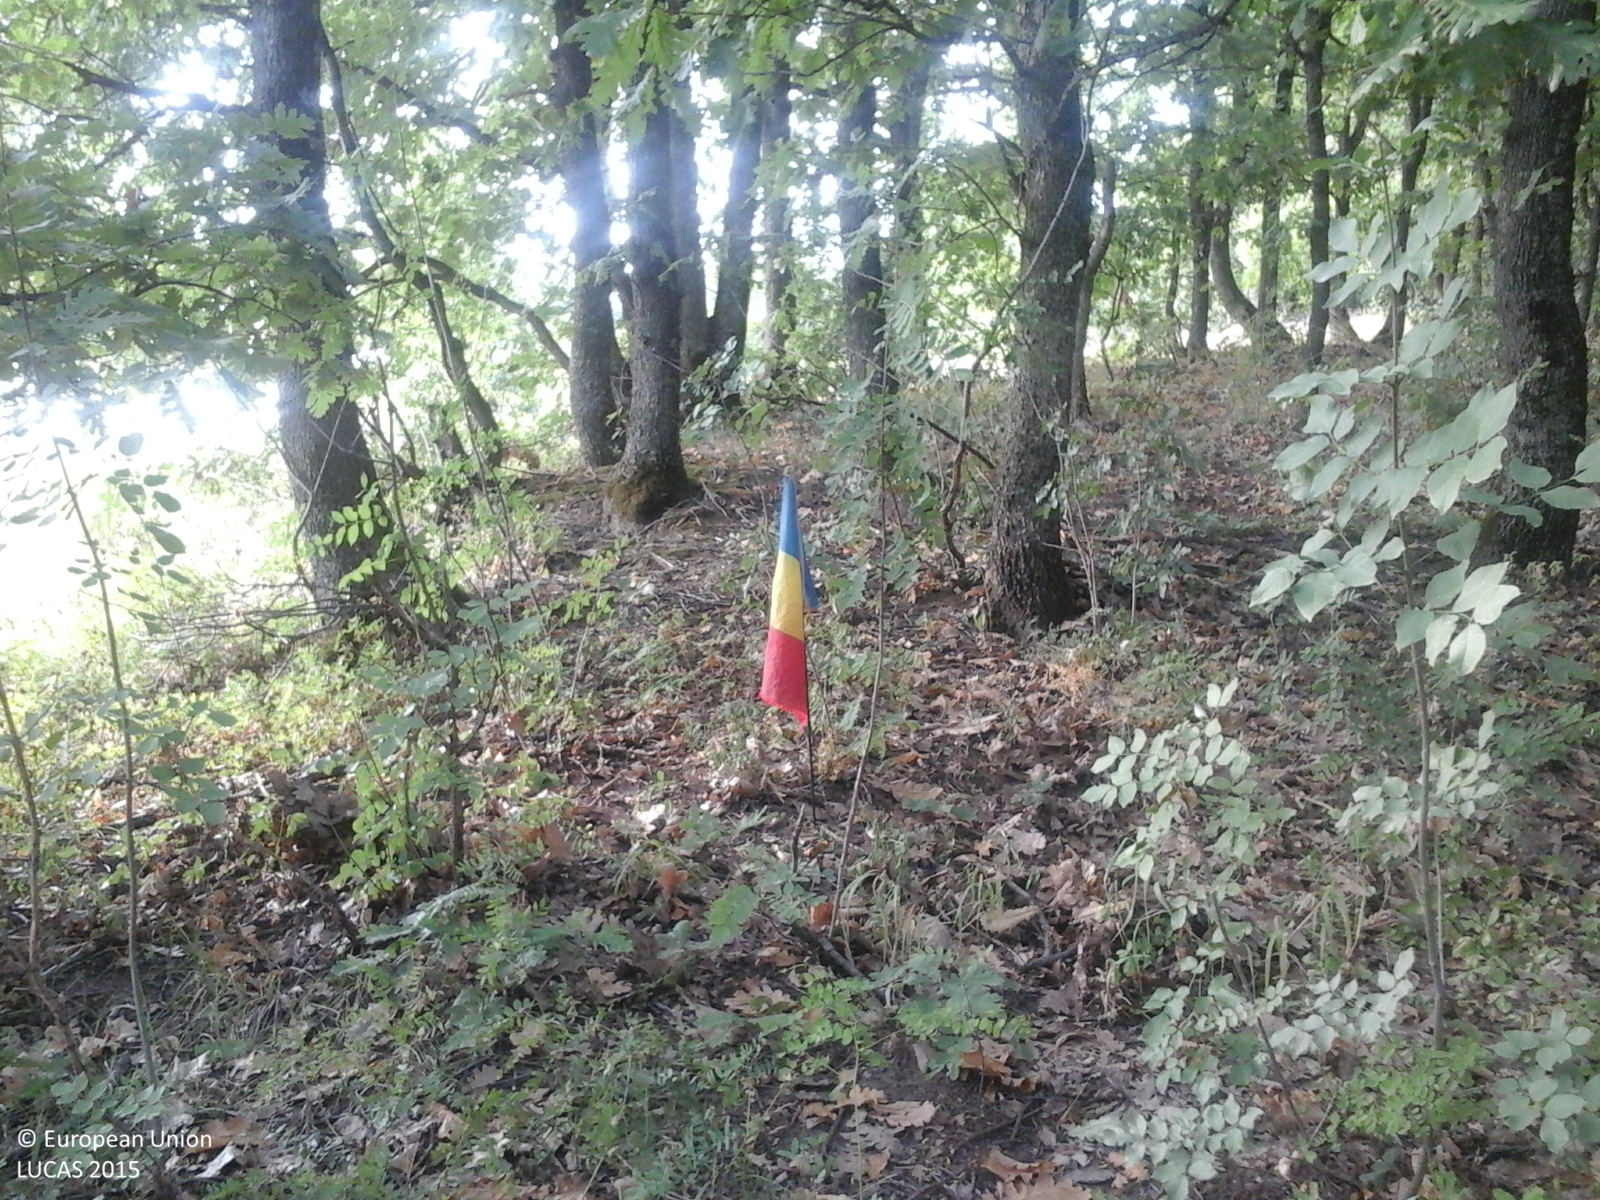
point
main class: Woodland
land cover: Broadleaved woodland
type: acidophilous oak and oak-birch forest
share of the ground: > 75 %
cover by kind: broadleaved forest trees 100 %
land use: Forestry
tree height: > 5 m
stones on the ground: < 10 %
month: August
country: RO
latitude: 44.7815
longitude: 23.6181
